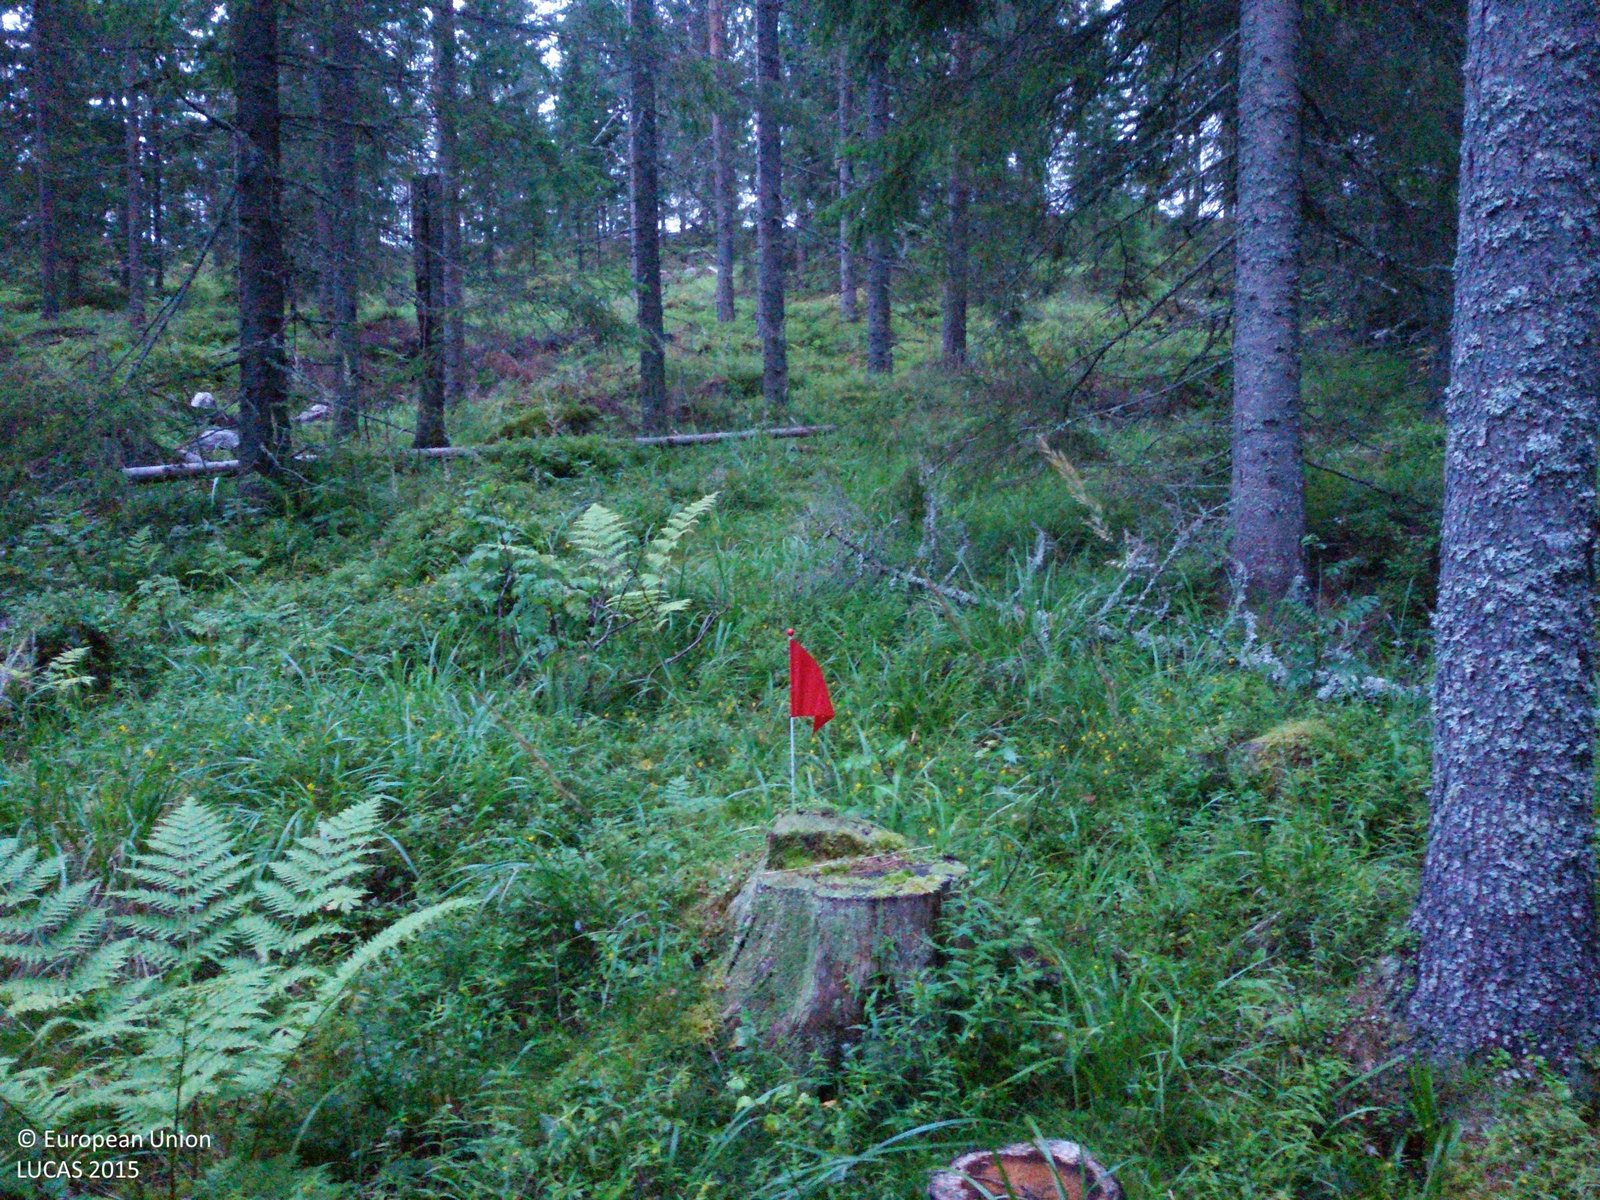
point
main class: Woodland
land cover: Spruce dominated coniferous woodland
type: boreal forest
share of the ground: 50 - 75 %
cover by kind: coniferous forest trees 60 %, herbaceous plants 20 %, lichens and mosses 15 %, shrubs 5 %
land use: Forestry
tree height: > 5 m
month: August
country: SE
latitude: 60.8987
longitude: 16.4934
